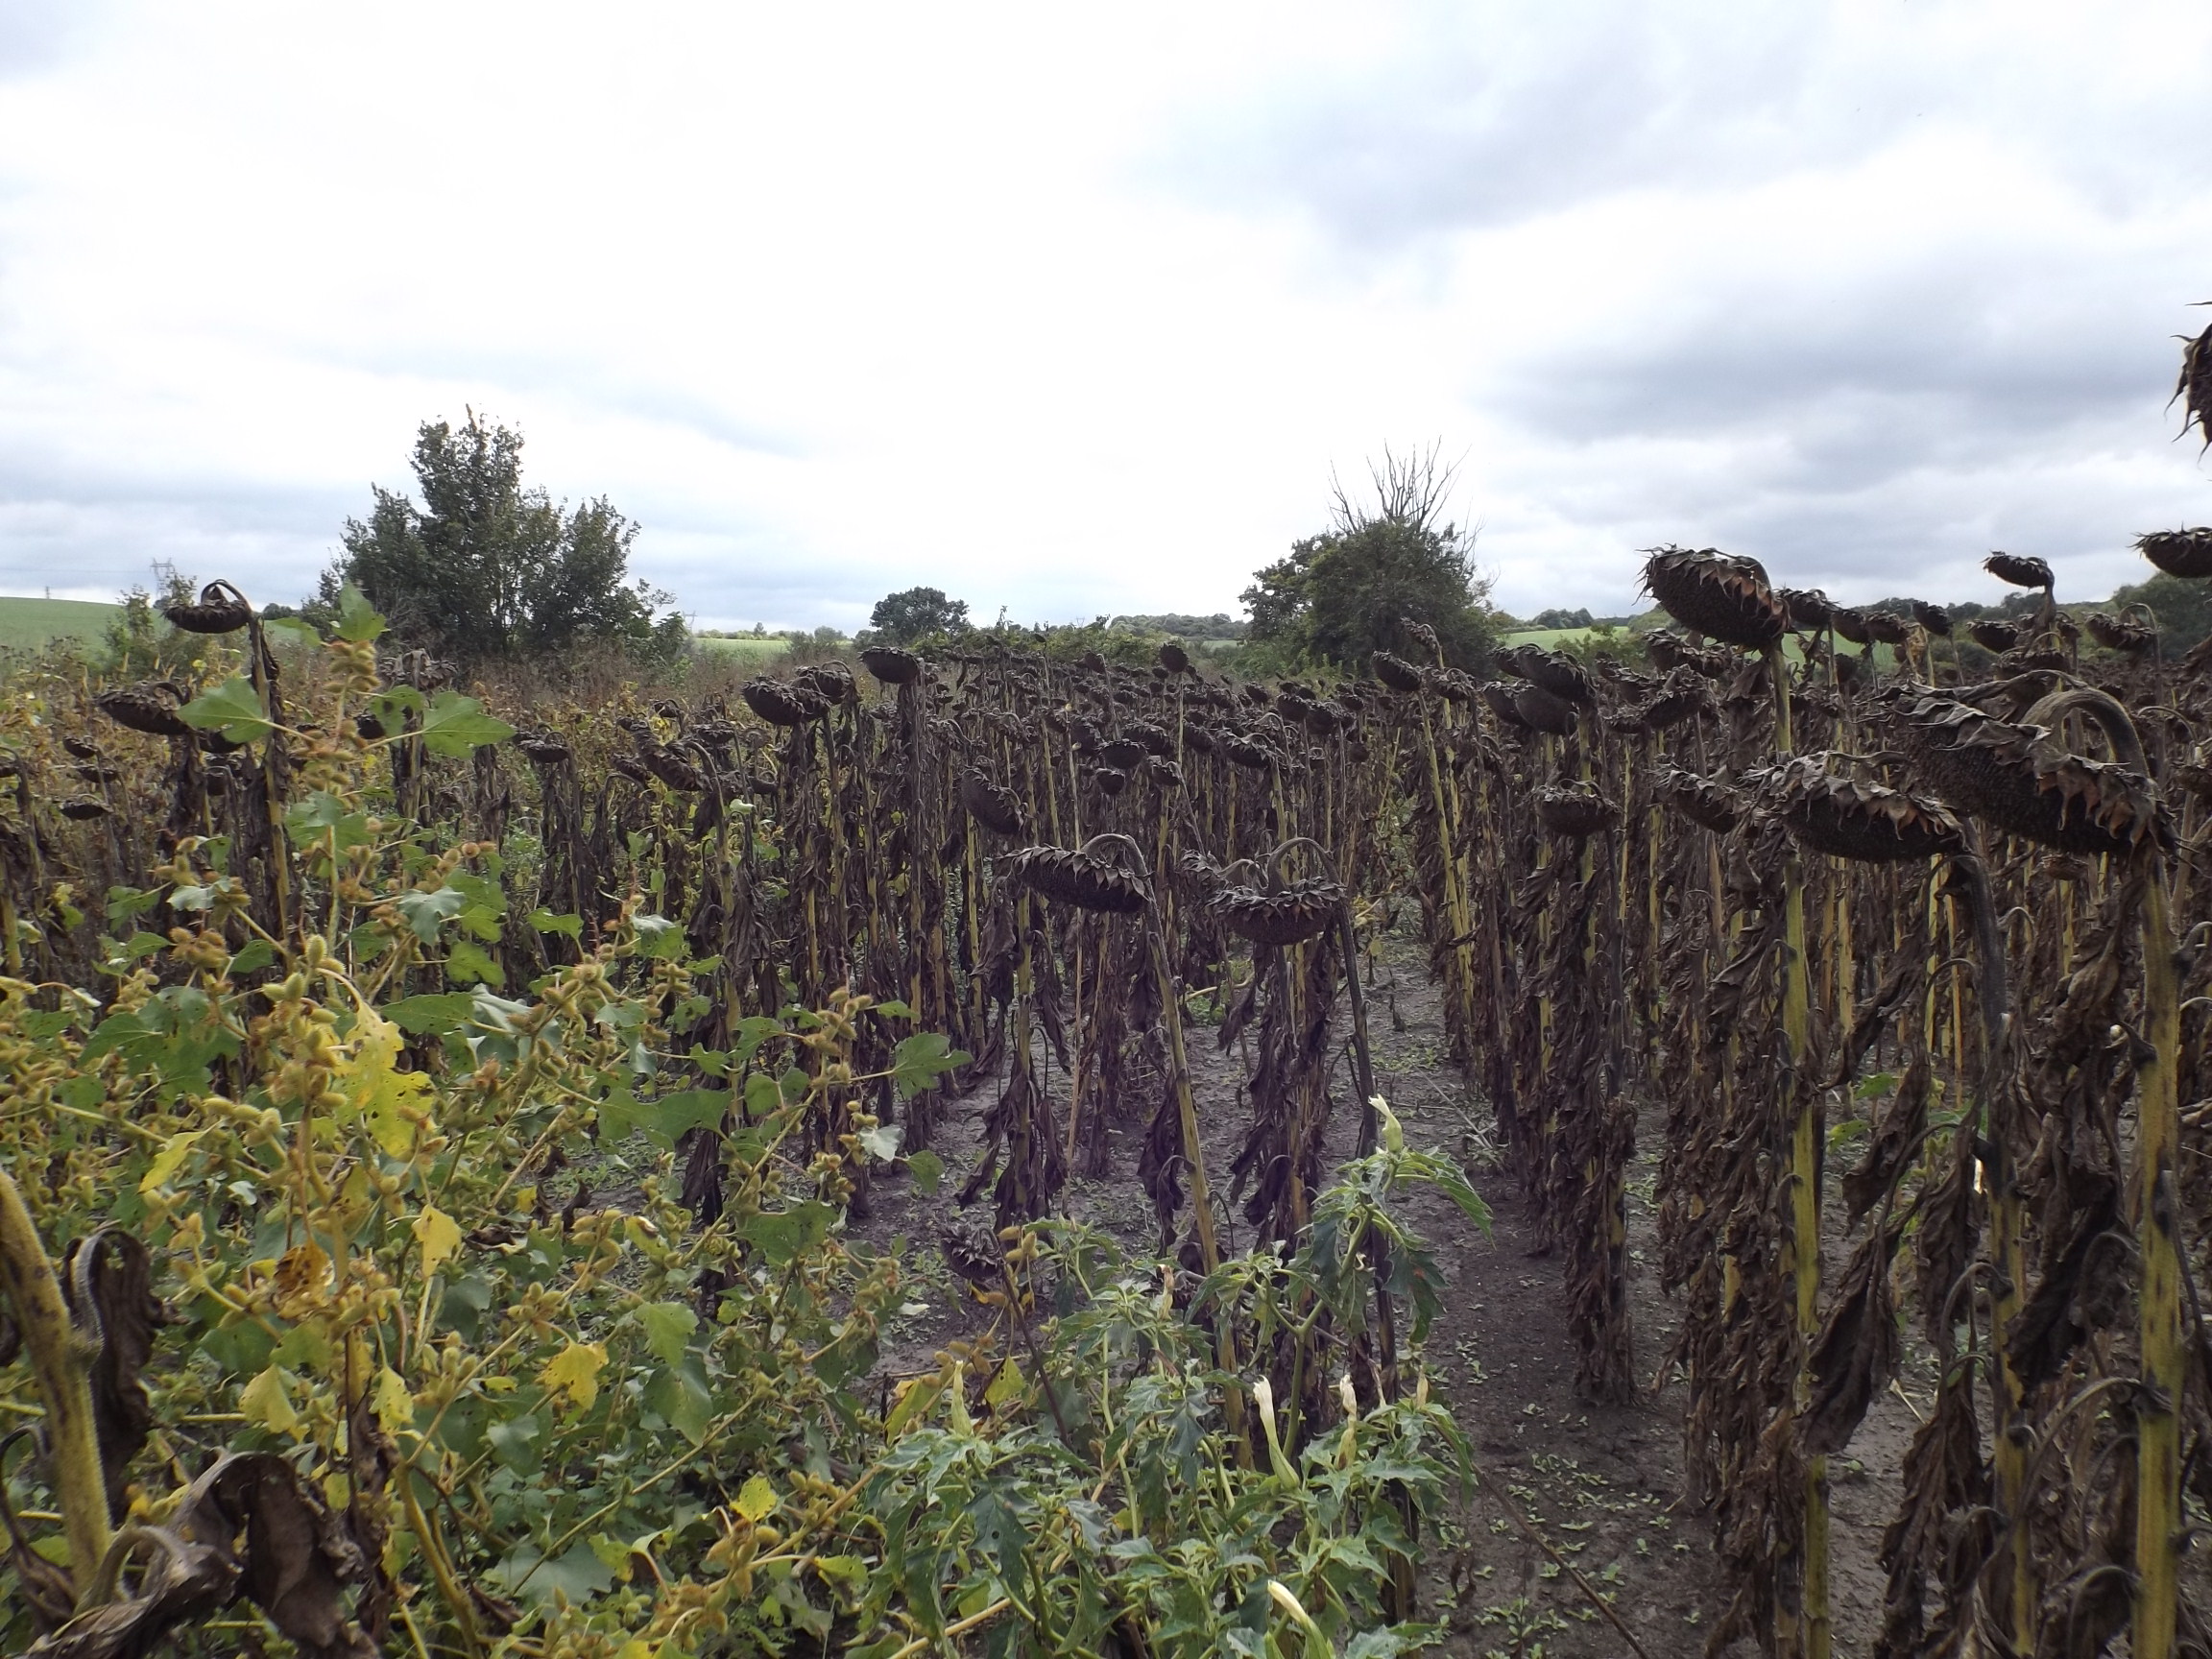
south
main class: Cropland
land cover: Sunflower
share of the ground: > 75 %
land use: Agriculture (excluding fallow land and kitchen gardens)
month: September
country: BG
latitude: 43.0873
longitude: 27.5080
